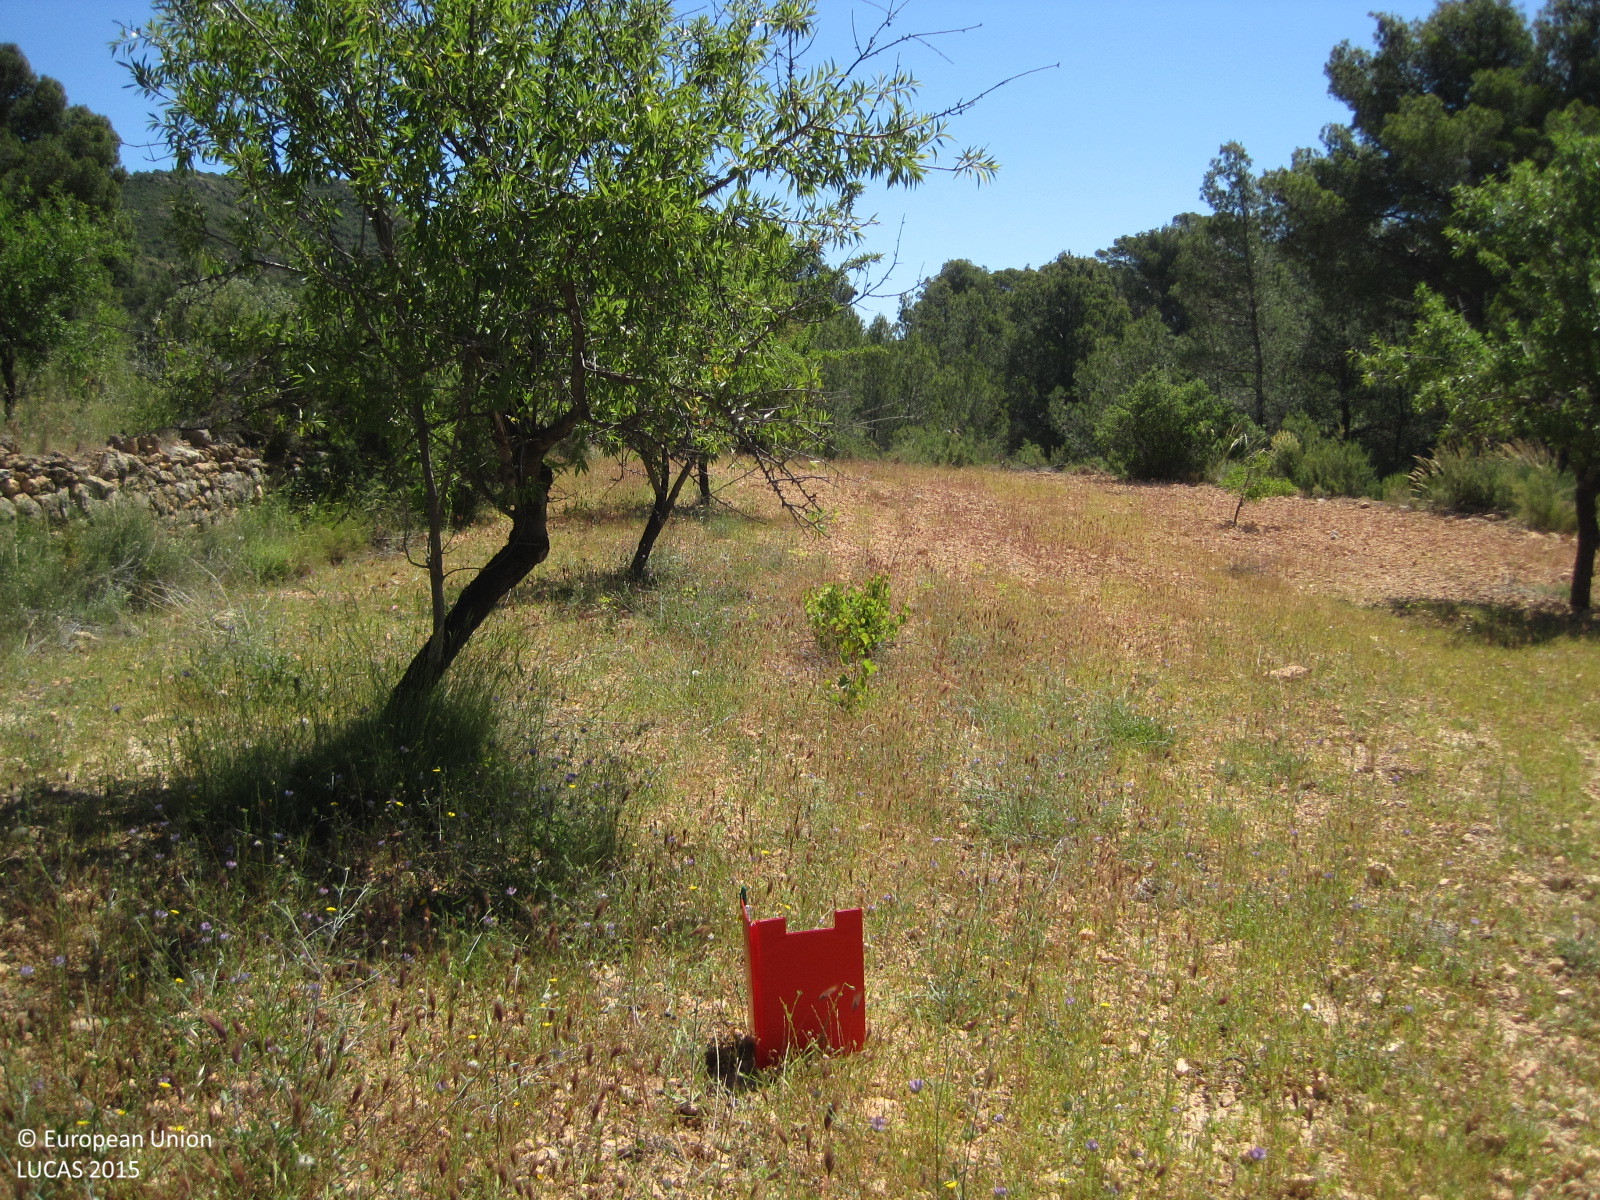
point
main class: Cropland
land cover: Nuts trees
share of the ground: 10 - 25 %
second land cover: Spontaneously vegetated surfaces
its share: > 75 %
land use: Agriculture (excluding fallow land and kitchen gardens)
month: May
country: ES
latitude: 39.7503
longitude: -0.7275
